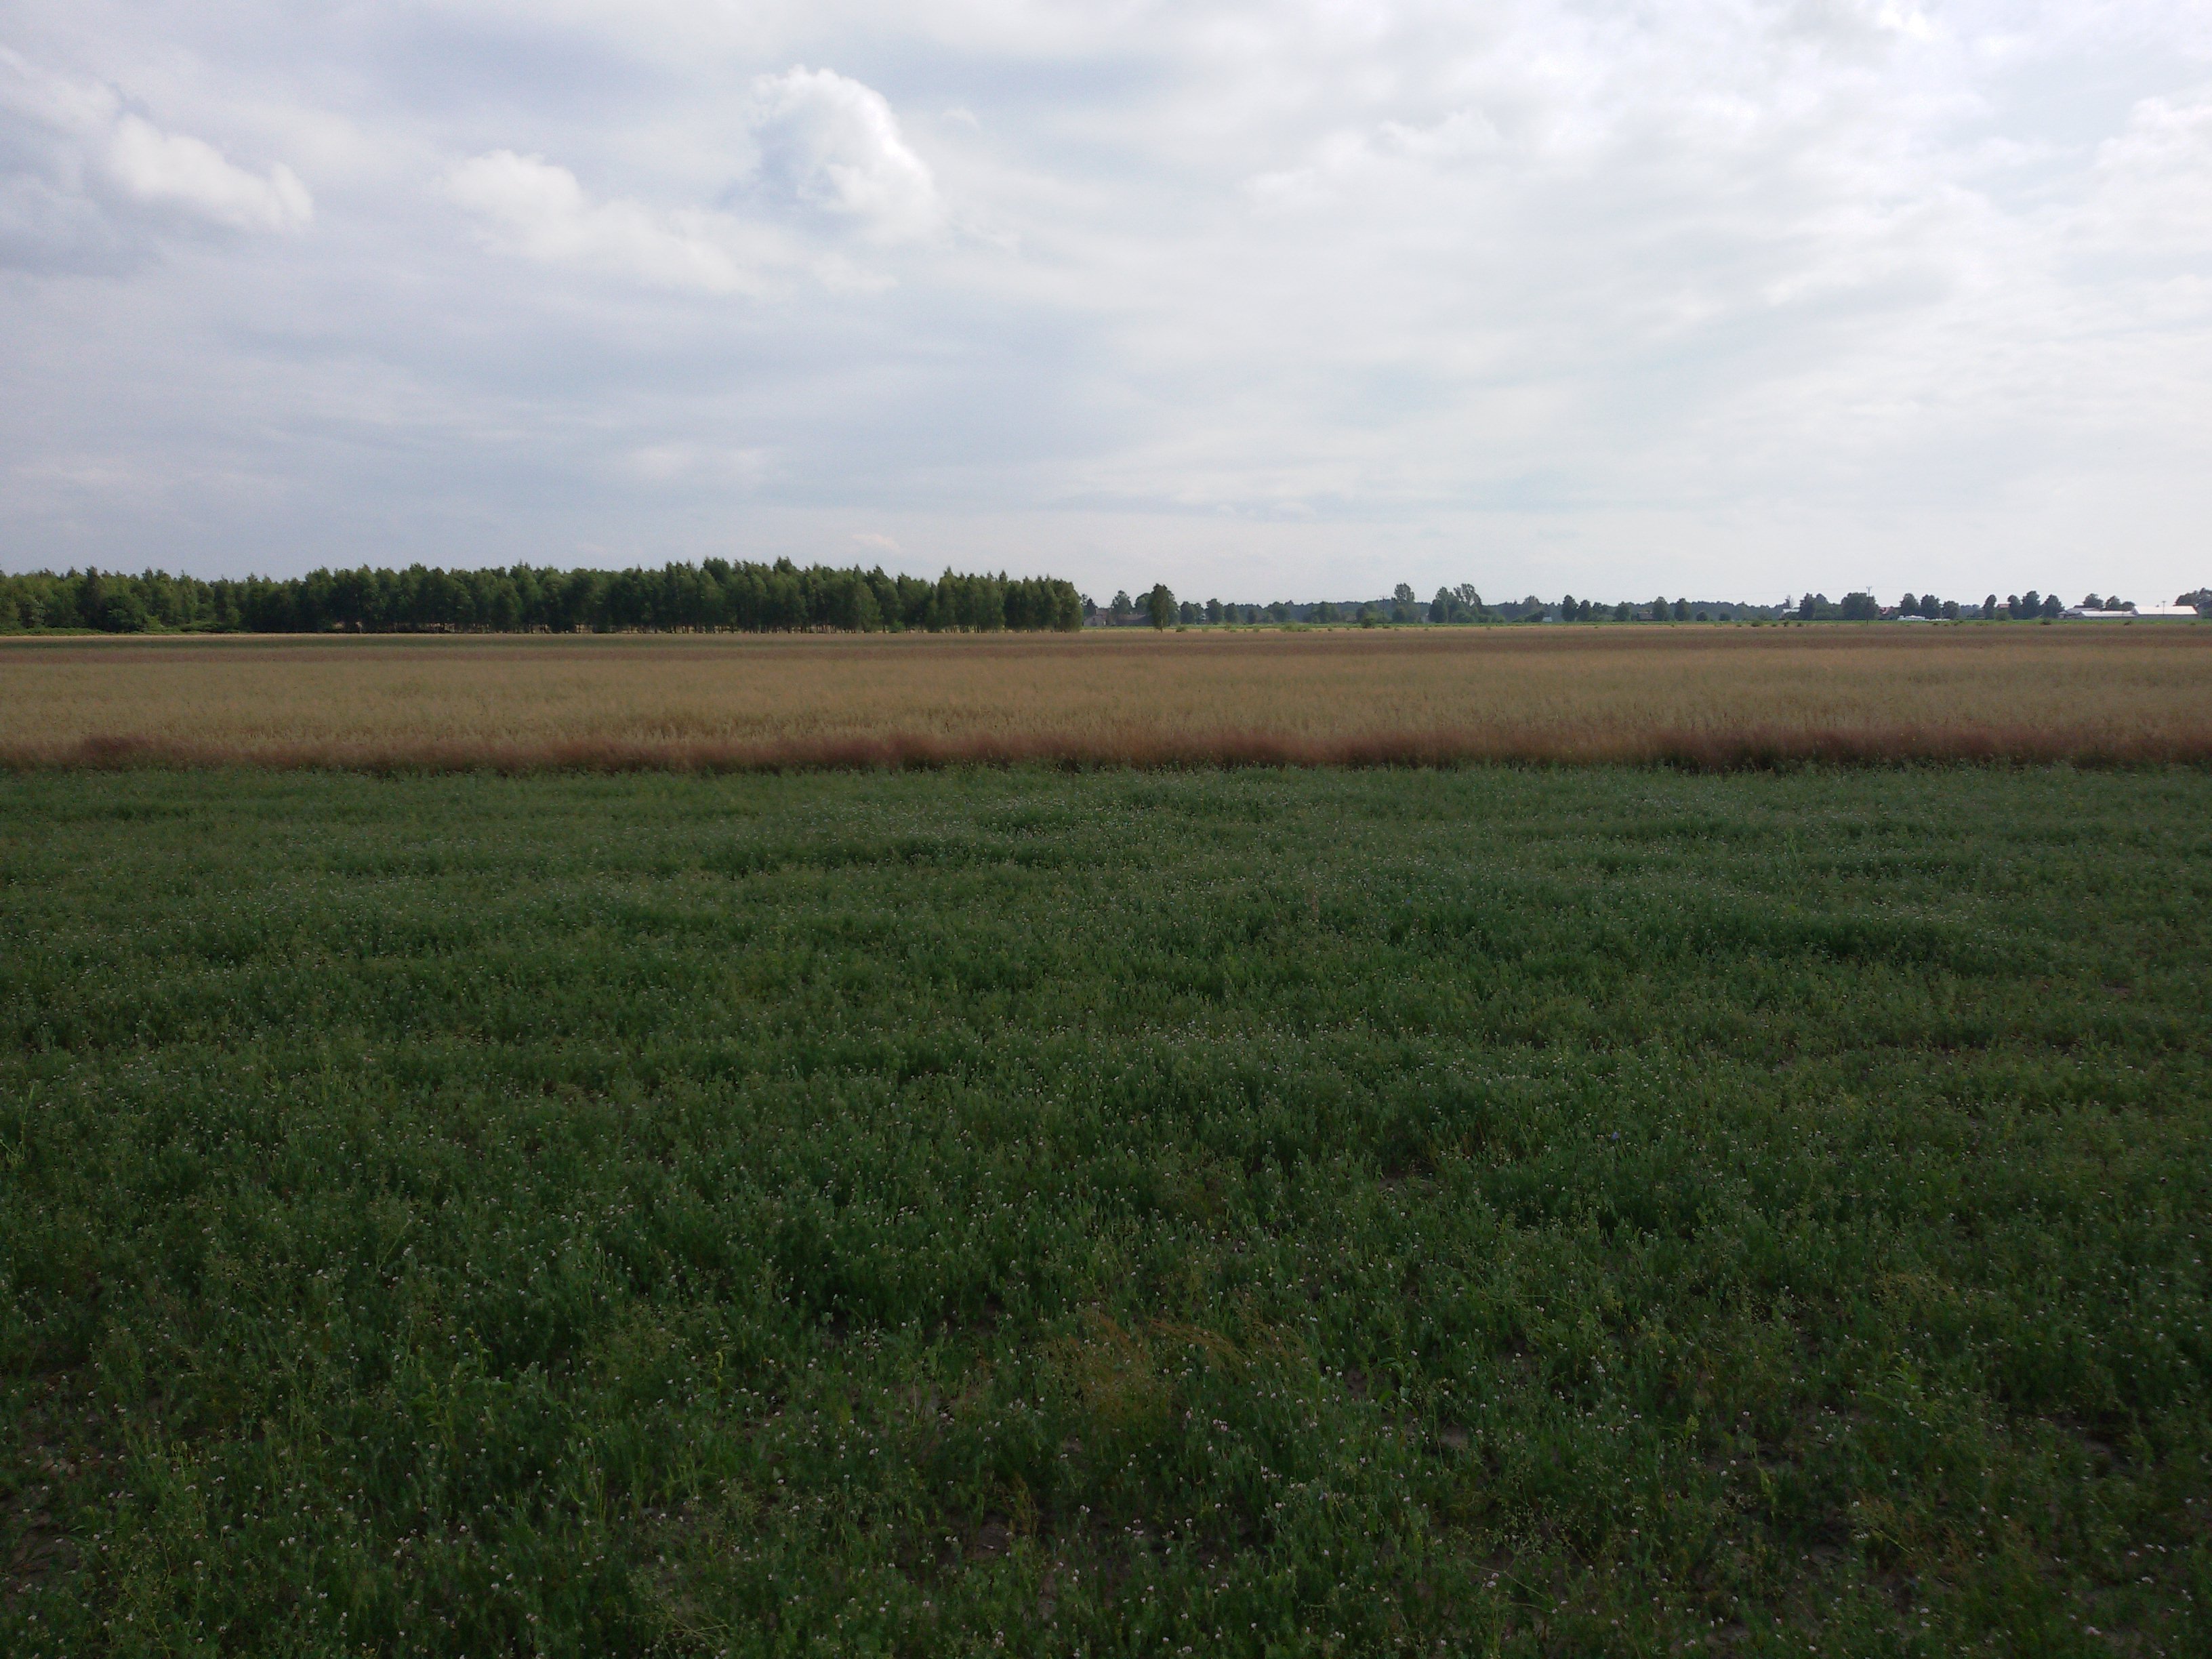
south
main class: Cropland
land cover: Dry pulses
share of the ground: > 75 %
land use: Agriculture (excluding fallow land and kitchen gardens)
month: July
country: PL
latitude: 51.9587
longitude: 22.9235
